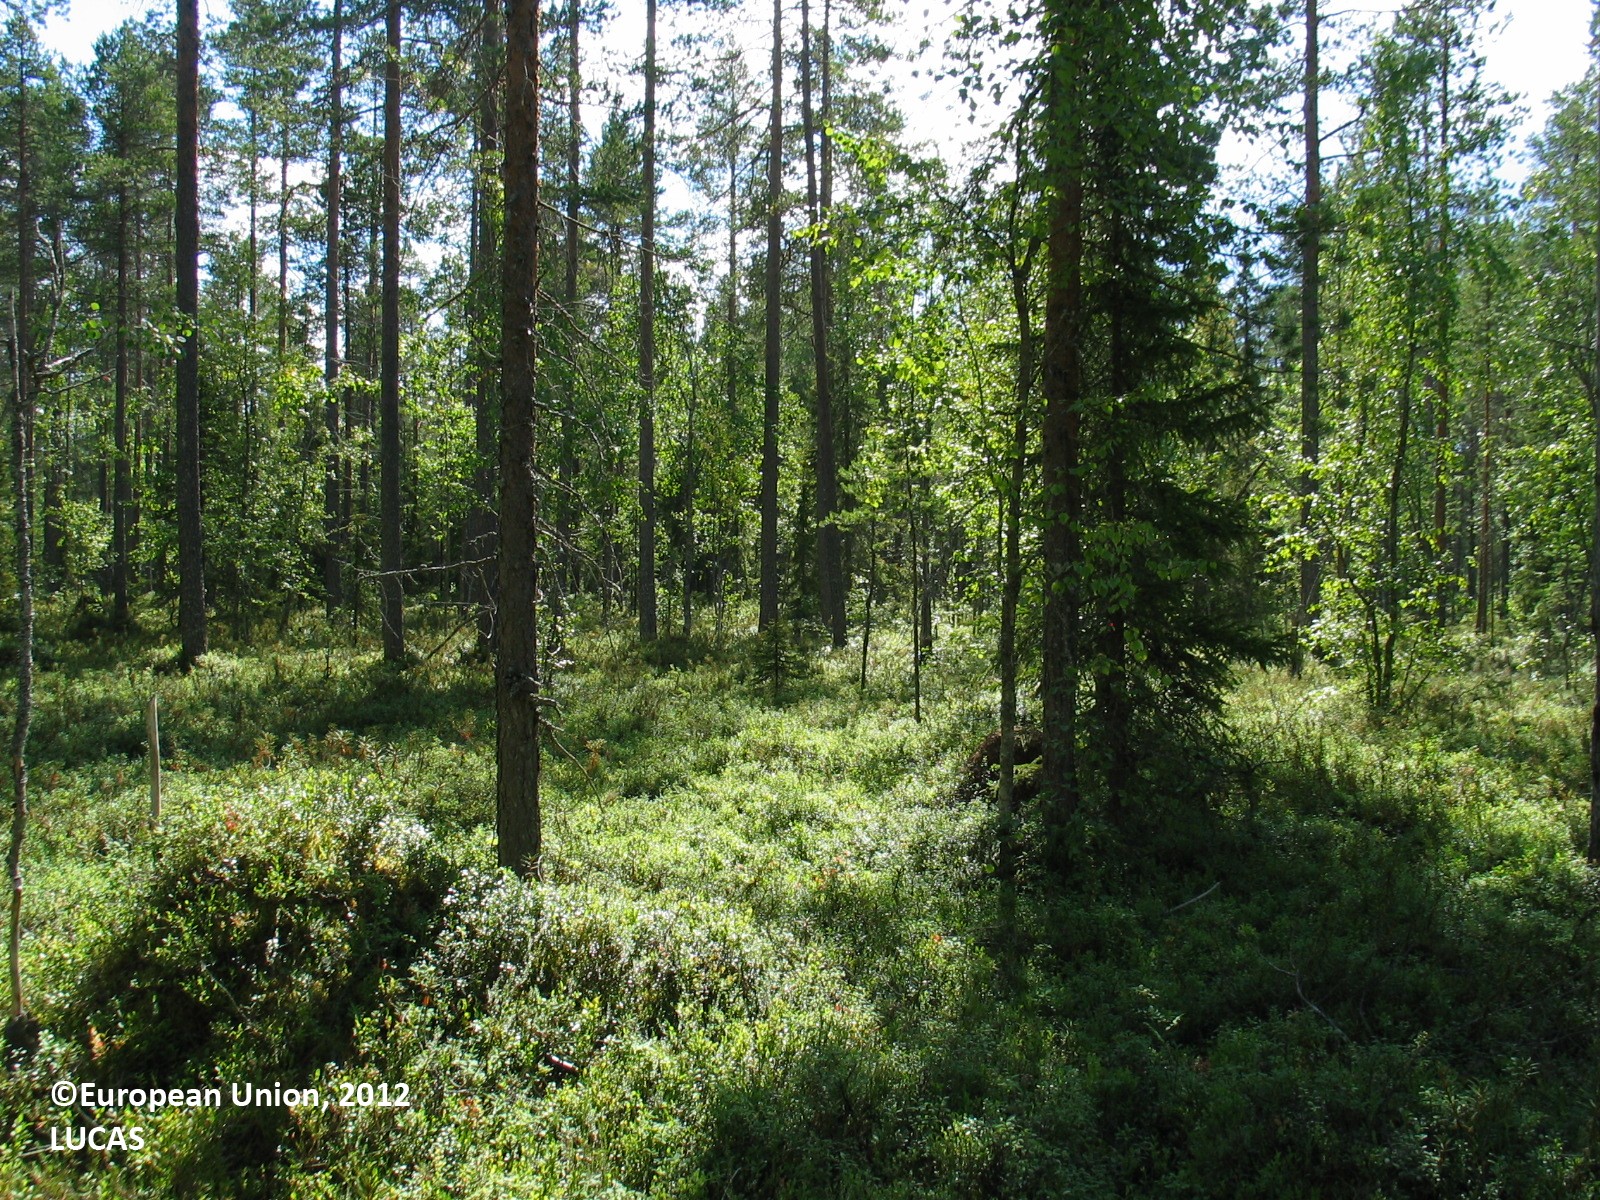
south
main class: Woodland
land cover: Pine dominated coniferous woodland
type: boreal forest
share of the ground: 25 - 50 %
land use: Forestry
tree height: > 5 m
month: August
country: FI
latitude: 65.7032
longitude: 25.8741
